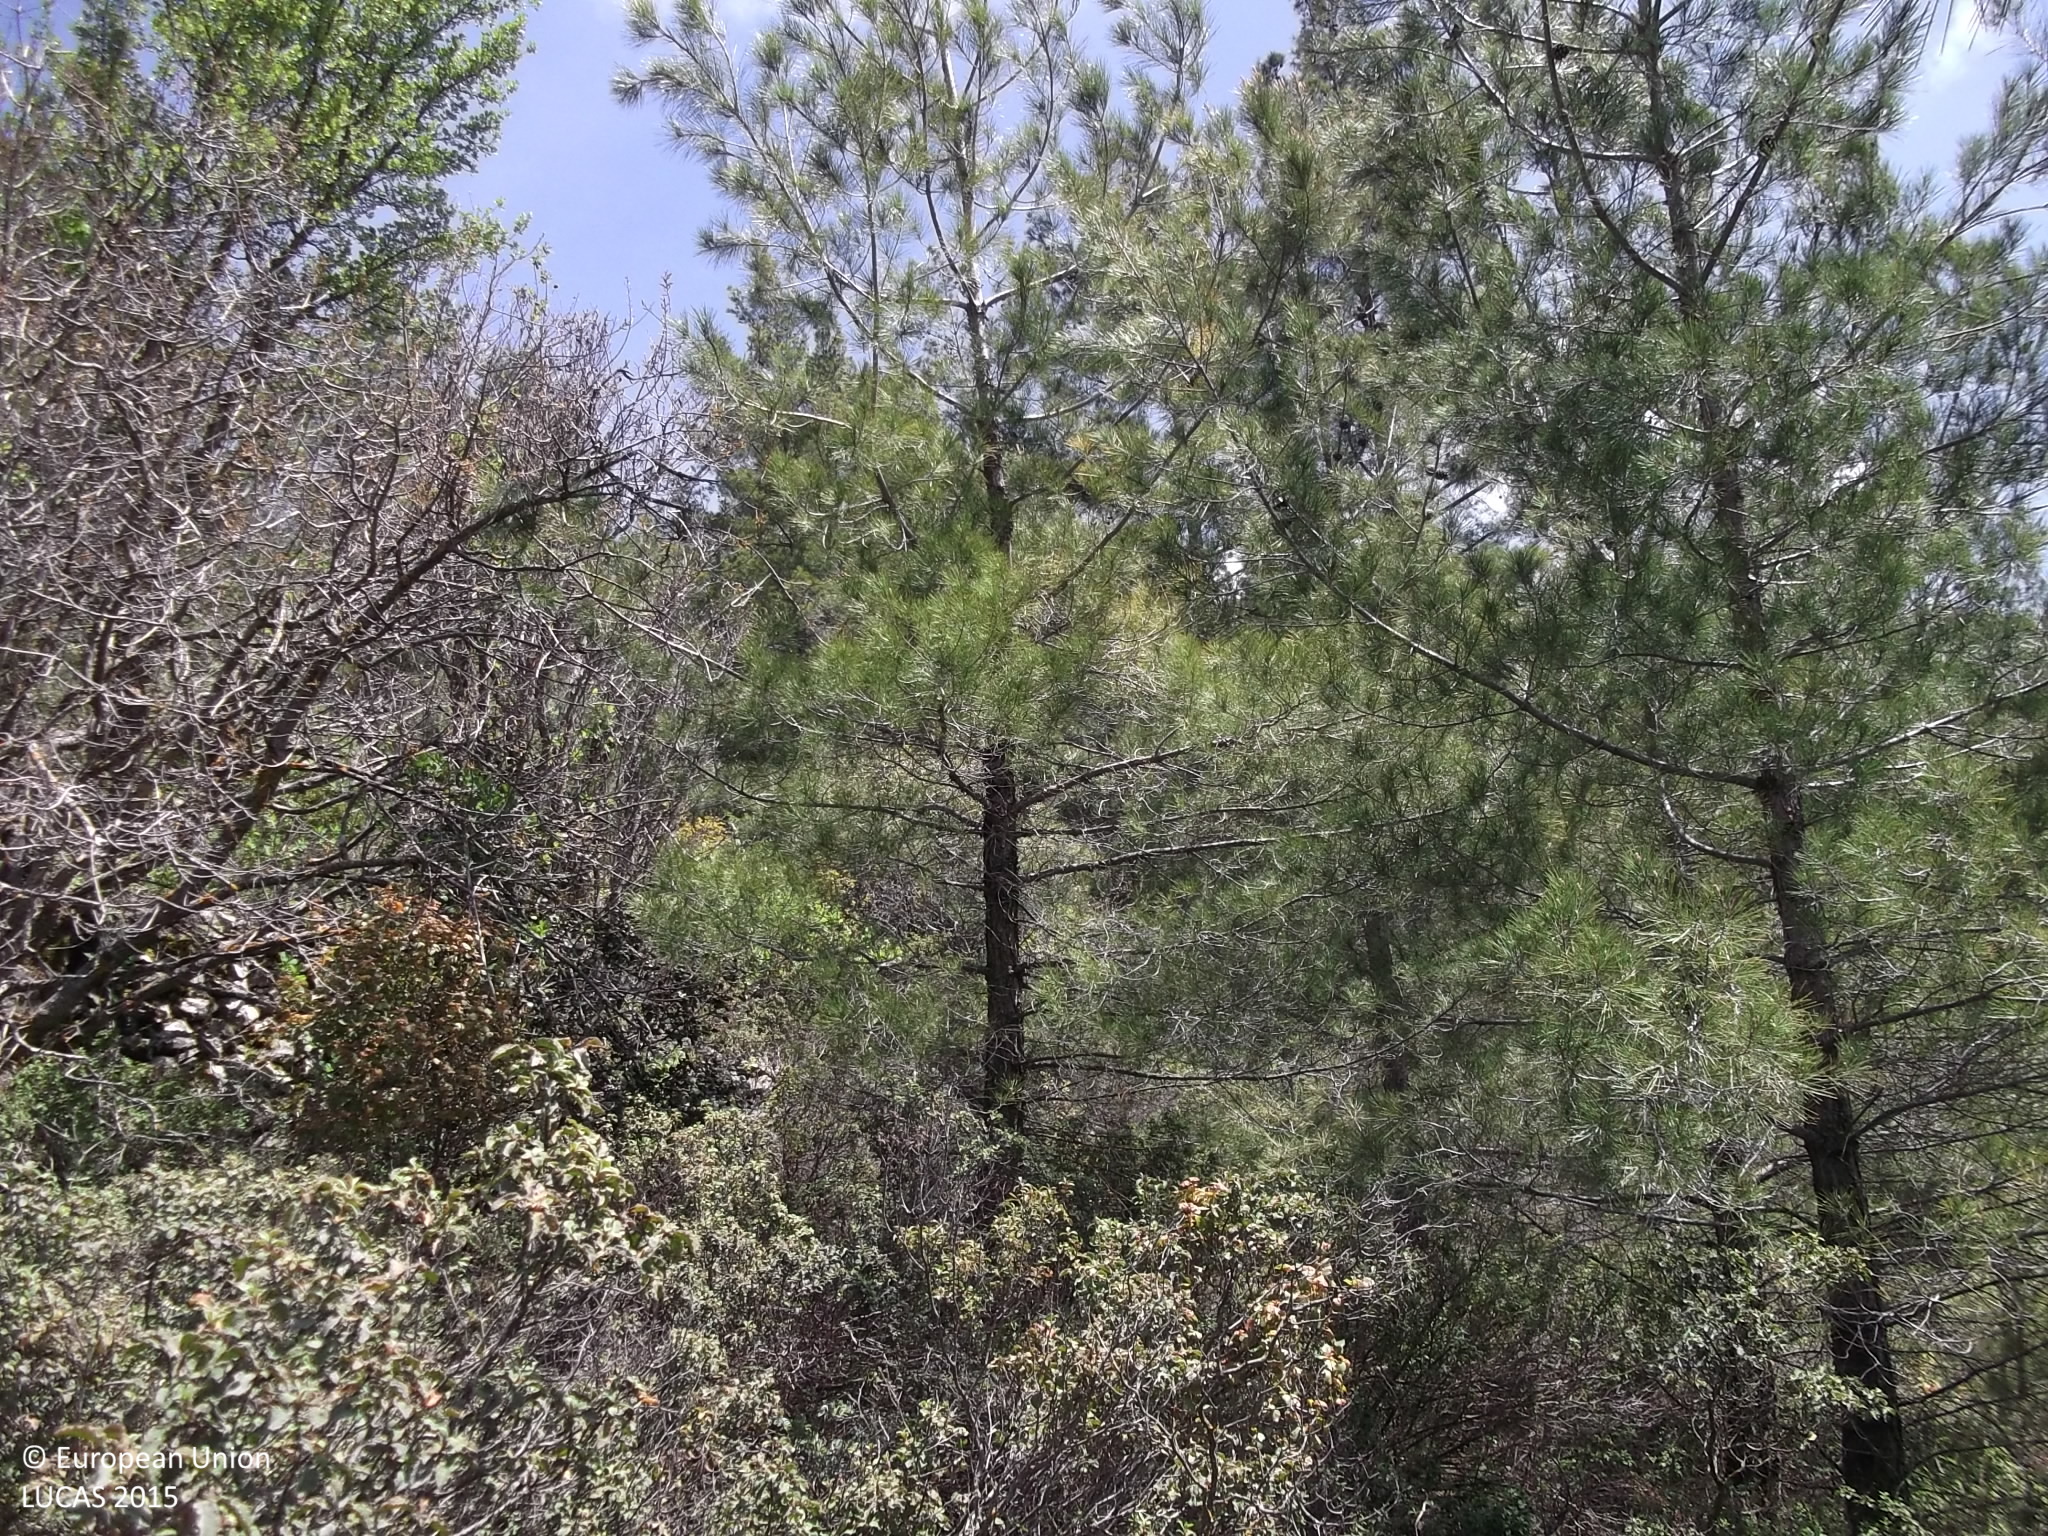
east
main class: Woodland
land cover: Pine dominated mixed woodland
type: coniferous forest of the mediterranean region
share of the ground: 25 - 50 %
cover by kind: shrubs 40 %, coniferous forest trees 35 %, broadleaved forest trees 15 %, consolidated bare surface 5 %, unconsolidated bare surface 5 %
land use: Semi-natural and natural areas not in use
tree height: > 5 m
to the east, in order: Pine dominated mixed woodland; Paved roads, cycling and walking lanes; Dry stone walls; Pine dominated coniferous woodland
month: April
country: CY
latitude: 34.9124
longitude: 33.1962
